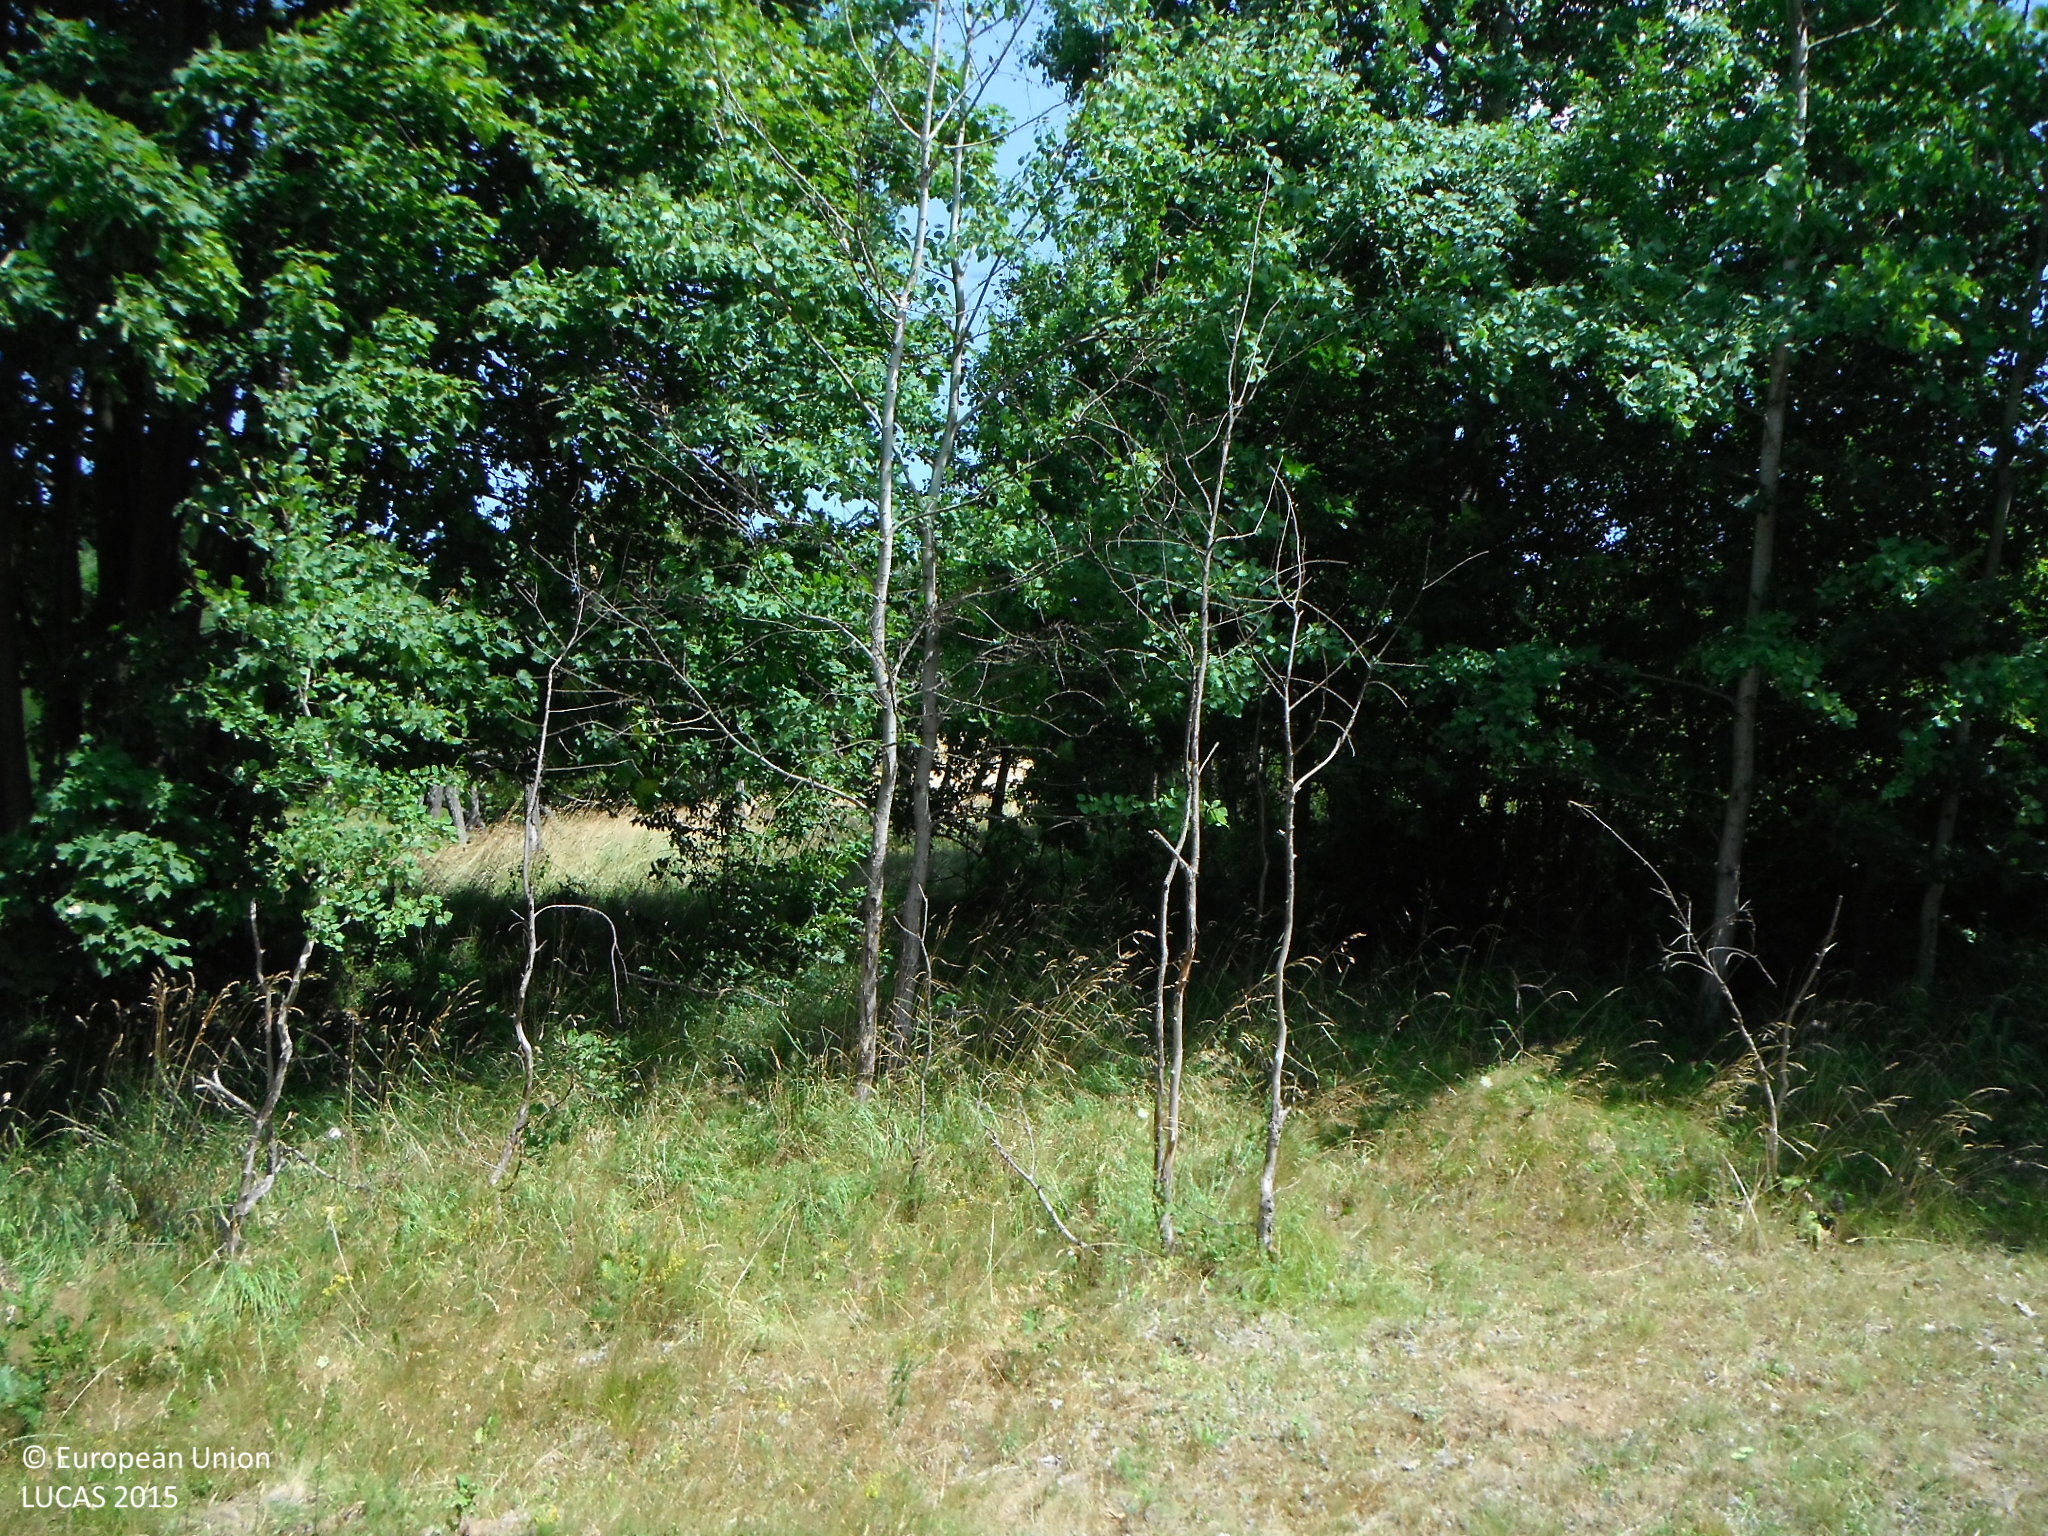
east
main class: Grassland
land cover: Grassland with sparse tree/shrub cover
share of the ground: > 75 %
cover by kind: herbaceous plants 90 %, broadleaved forest trees 5 %, shrubs 5 %
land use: Agriculture (excluding fallow land and kitchen gardens)
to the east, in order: Grassland with sparse tree/shrub cover; Broadleaved woodland; Grassland without tree/shrub cover; Spontaneously vegetated surfaces; Grassland without tree/shrub cover; Spontaneously vegetated surfaces; Shrubland without tree cover
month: July
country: SK
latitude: 48.2730
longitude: 19.1972
